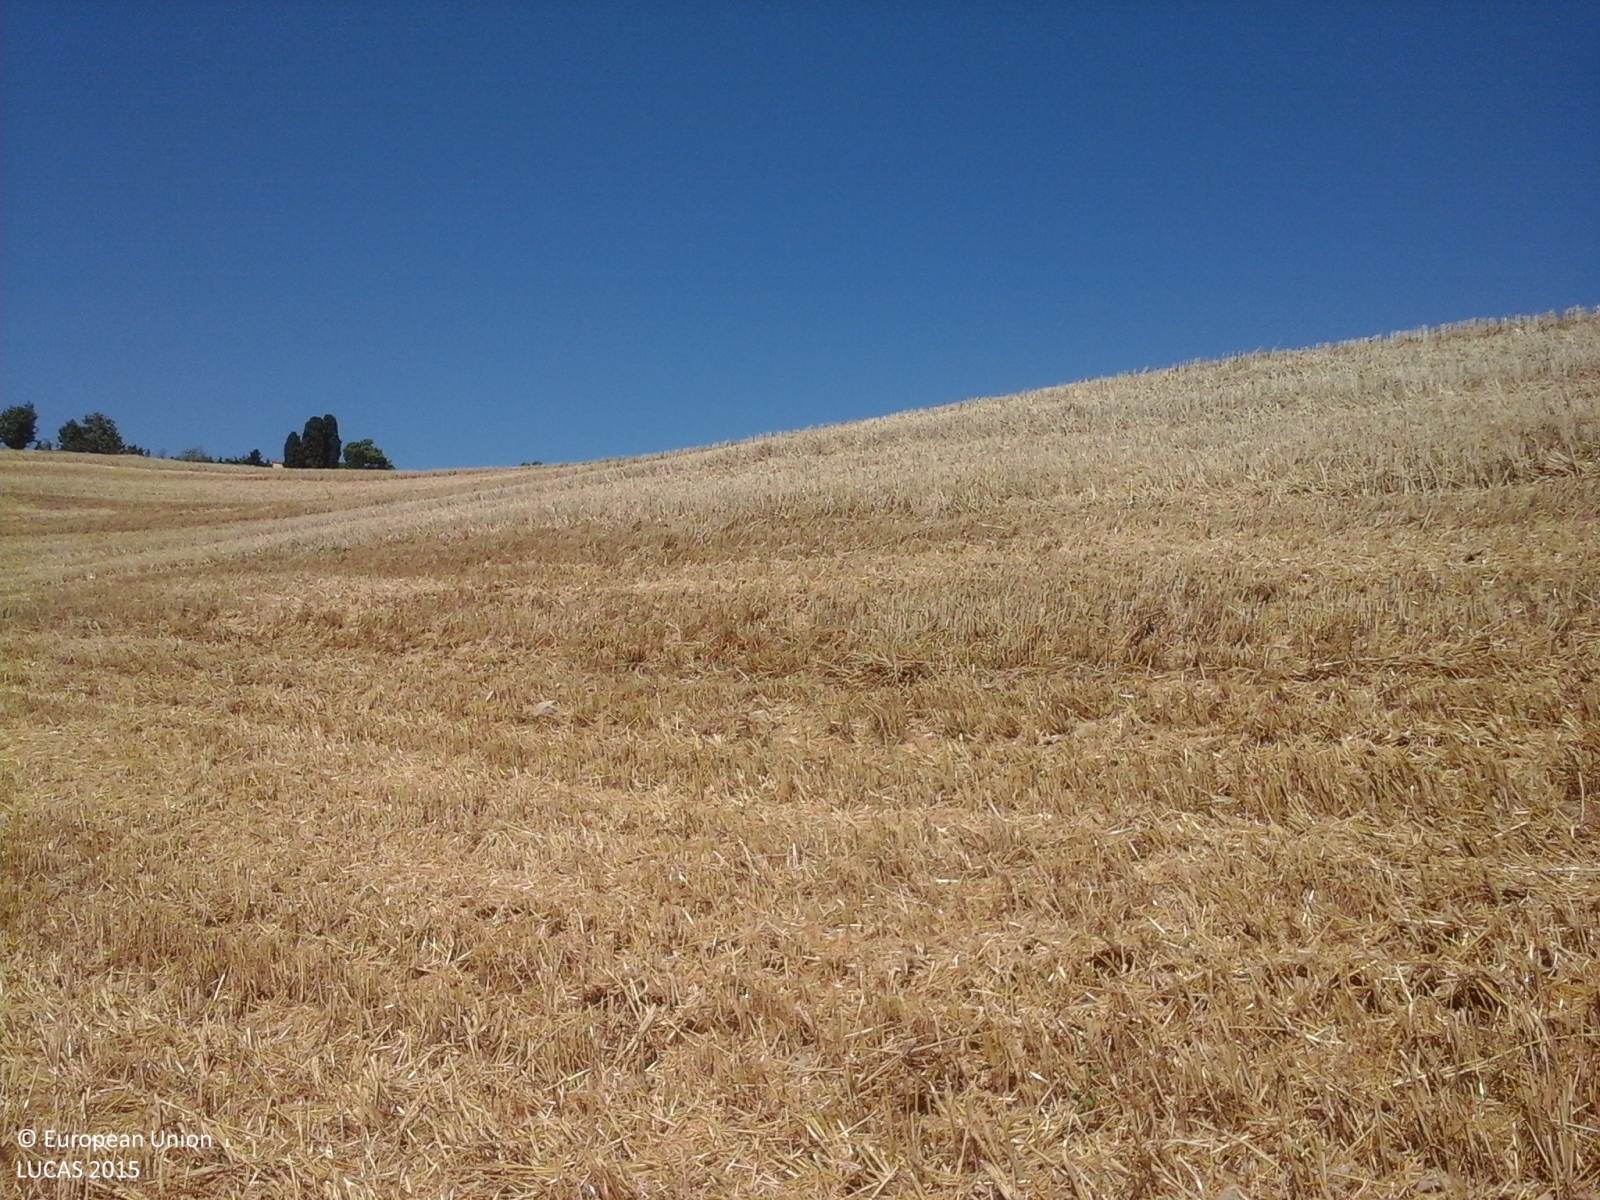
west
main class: Cropland
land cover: Durum wheat
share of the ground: > 75 %
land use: Agriculture (excluding fallow land and kitchen gardens)
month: June
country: IT
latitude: 43.5369
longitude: 10.6047
